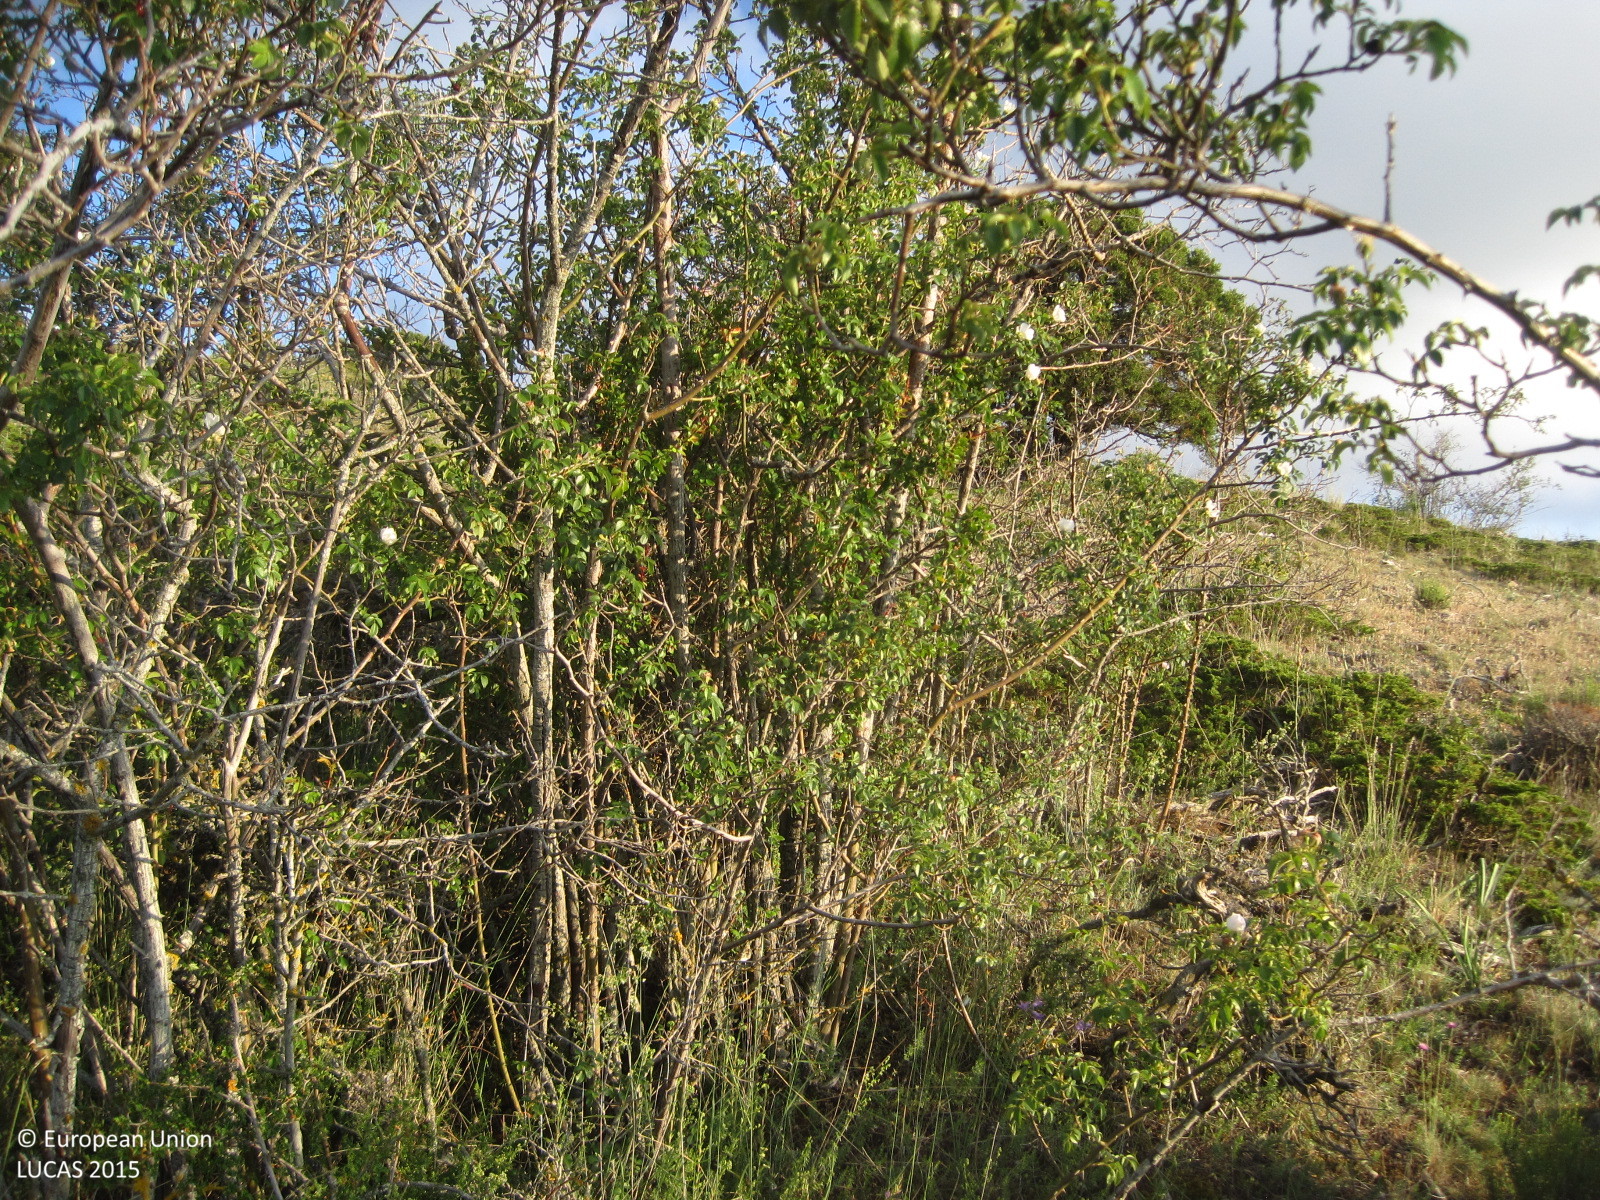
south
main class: Shrubland
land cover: Shrubland with sparse tree cover
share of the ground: 10 - 25 %
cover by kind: herbaceous plants 50 %, consolidated bare surface 25 %, shrubs 20 %, coniferous forest trees 5 %
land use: Semi-natural and natural areas not in use
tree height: < 5 m
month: June
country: ES
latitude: 39.9830
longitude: -0.9314
